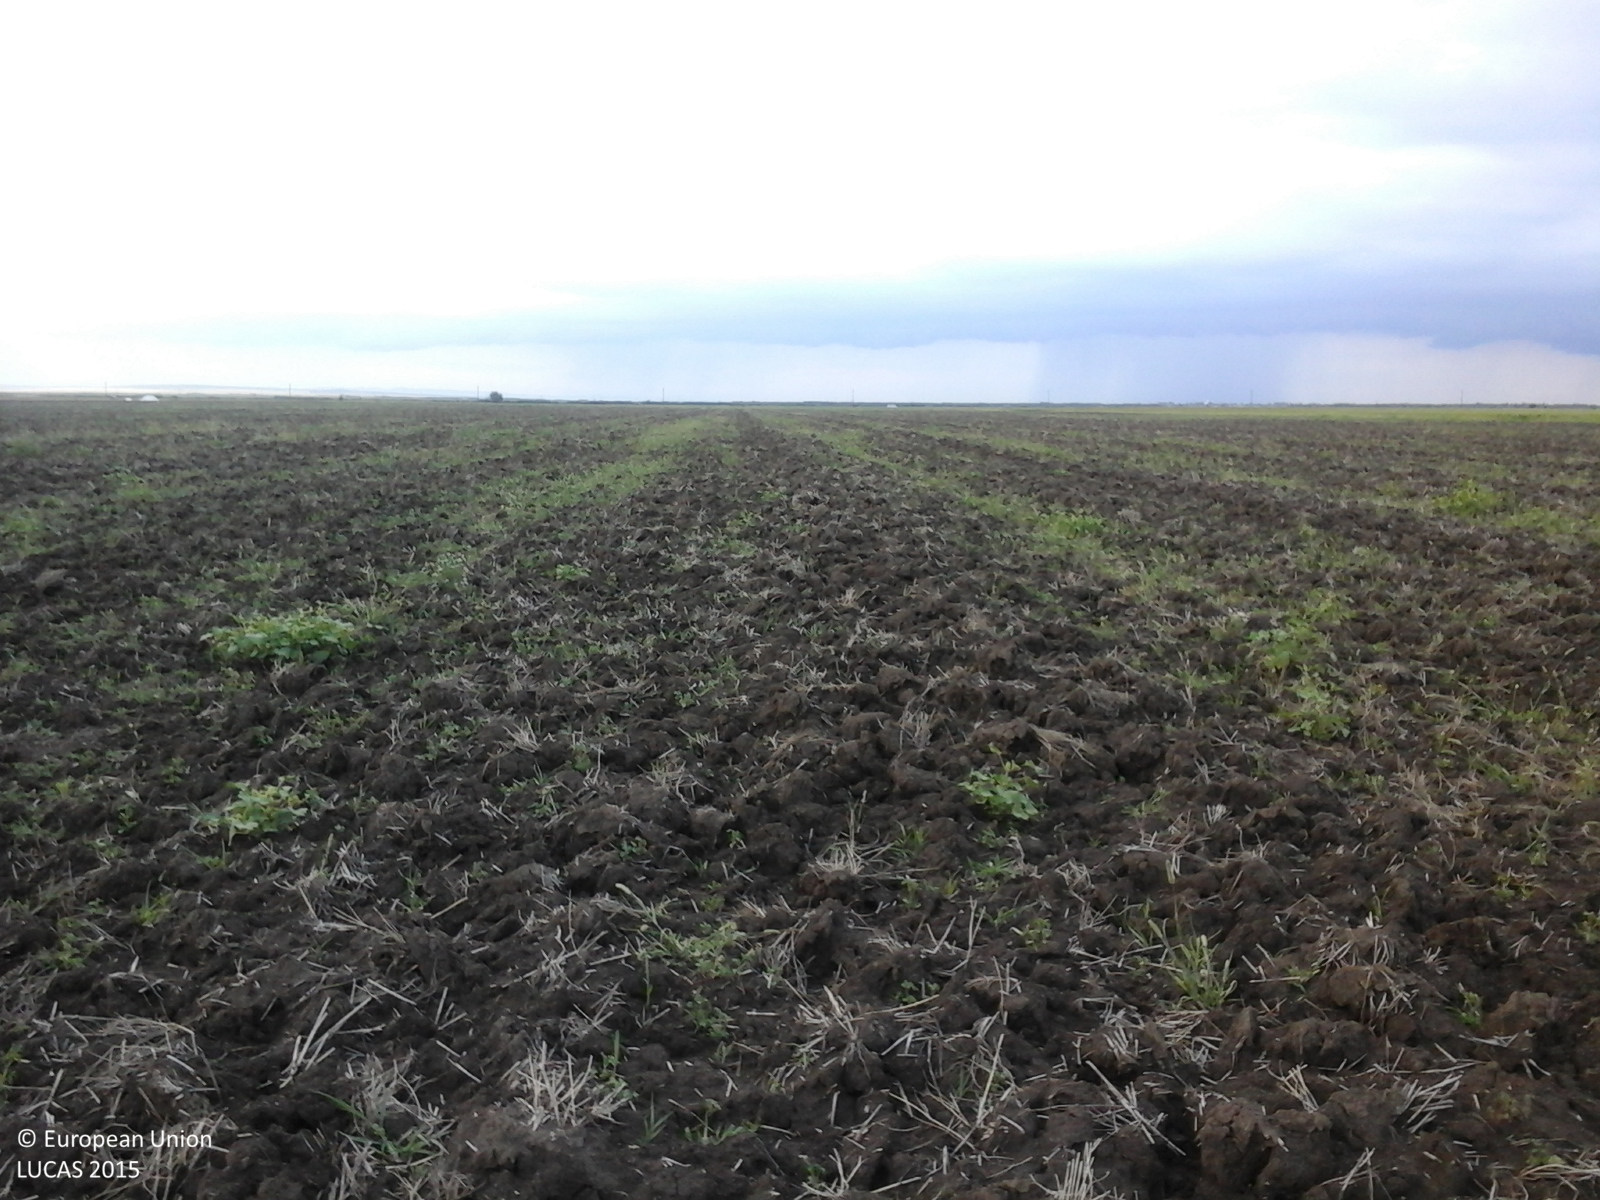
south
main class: Cropland
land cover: Common wheat
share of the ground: < 10 %
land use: Agriculture (excluding fallow land and kitchen gardens)
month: August
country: RO
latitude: 45.6717
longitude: 21.5224
